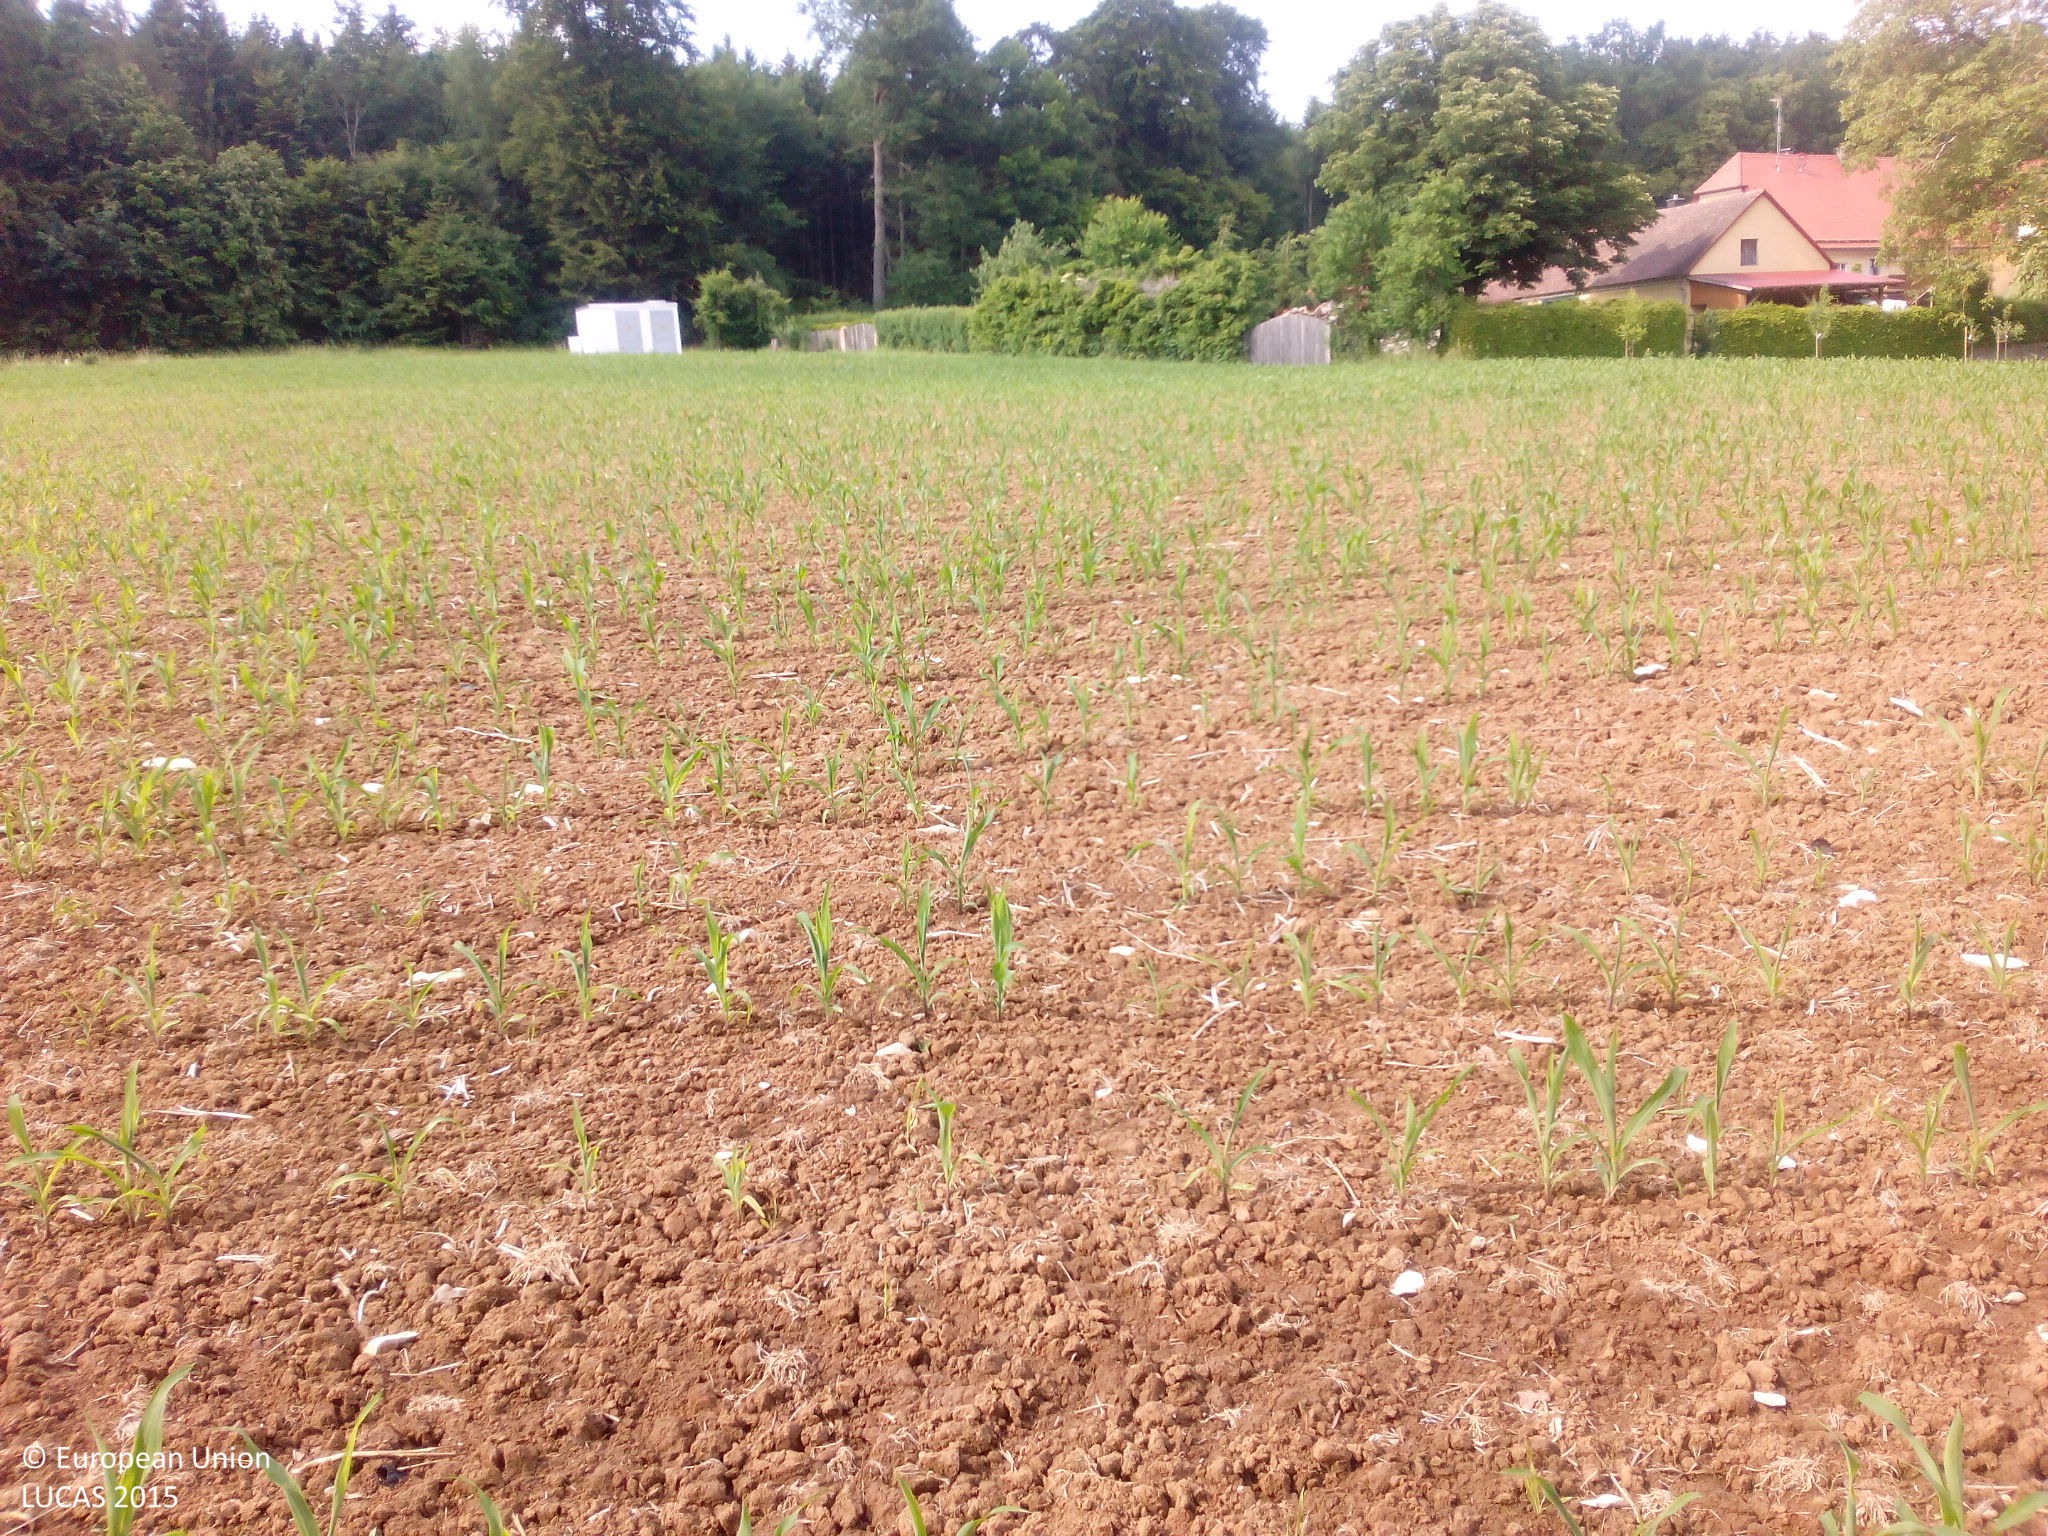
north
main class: Cropland
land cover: Maize
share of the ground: < 10 %
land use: Agriculture (excluding fallow land and kitchen gardens)
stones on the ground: < 10 %
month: June
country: DE
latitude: 48.9577
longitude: 10.8873
